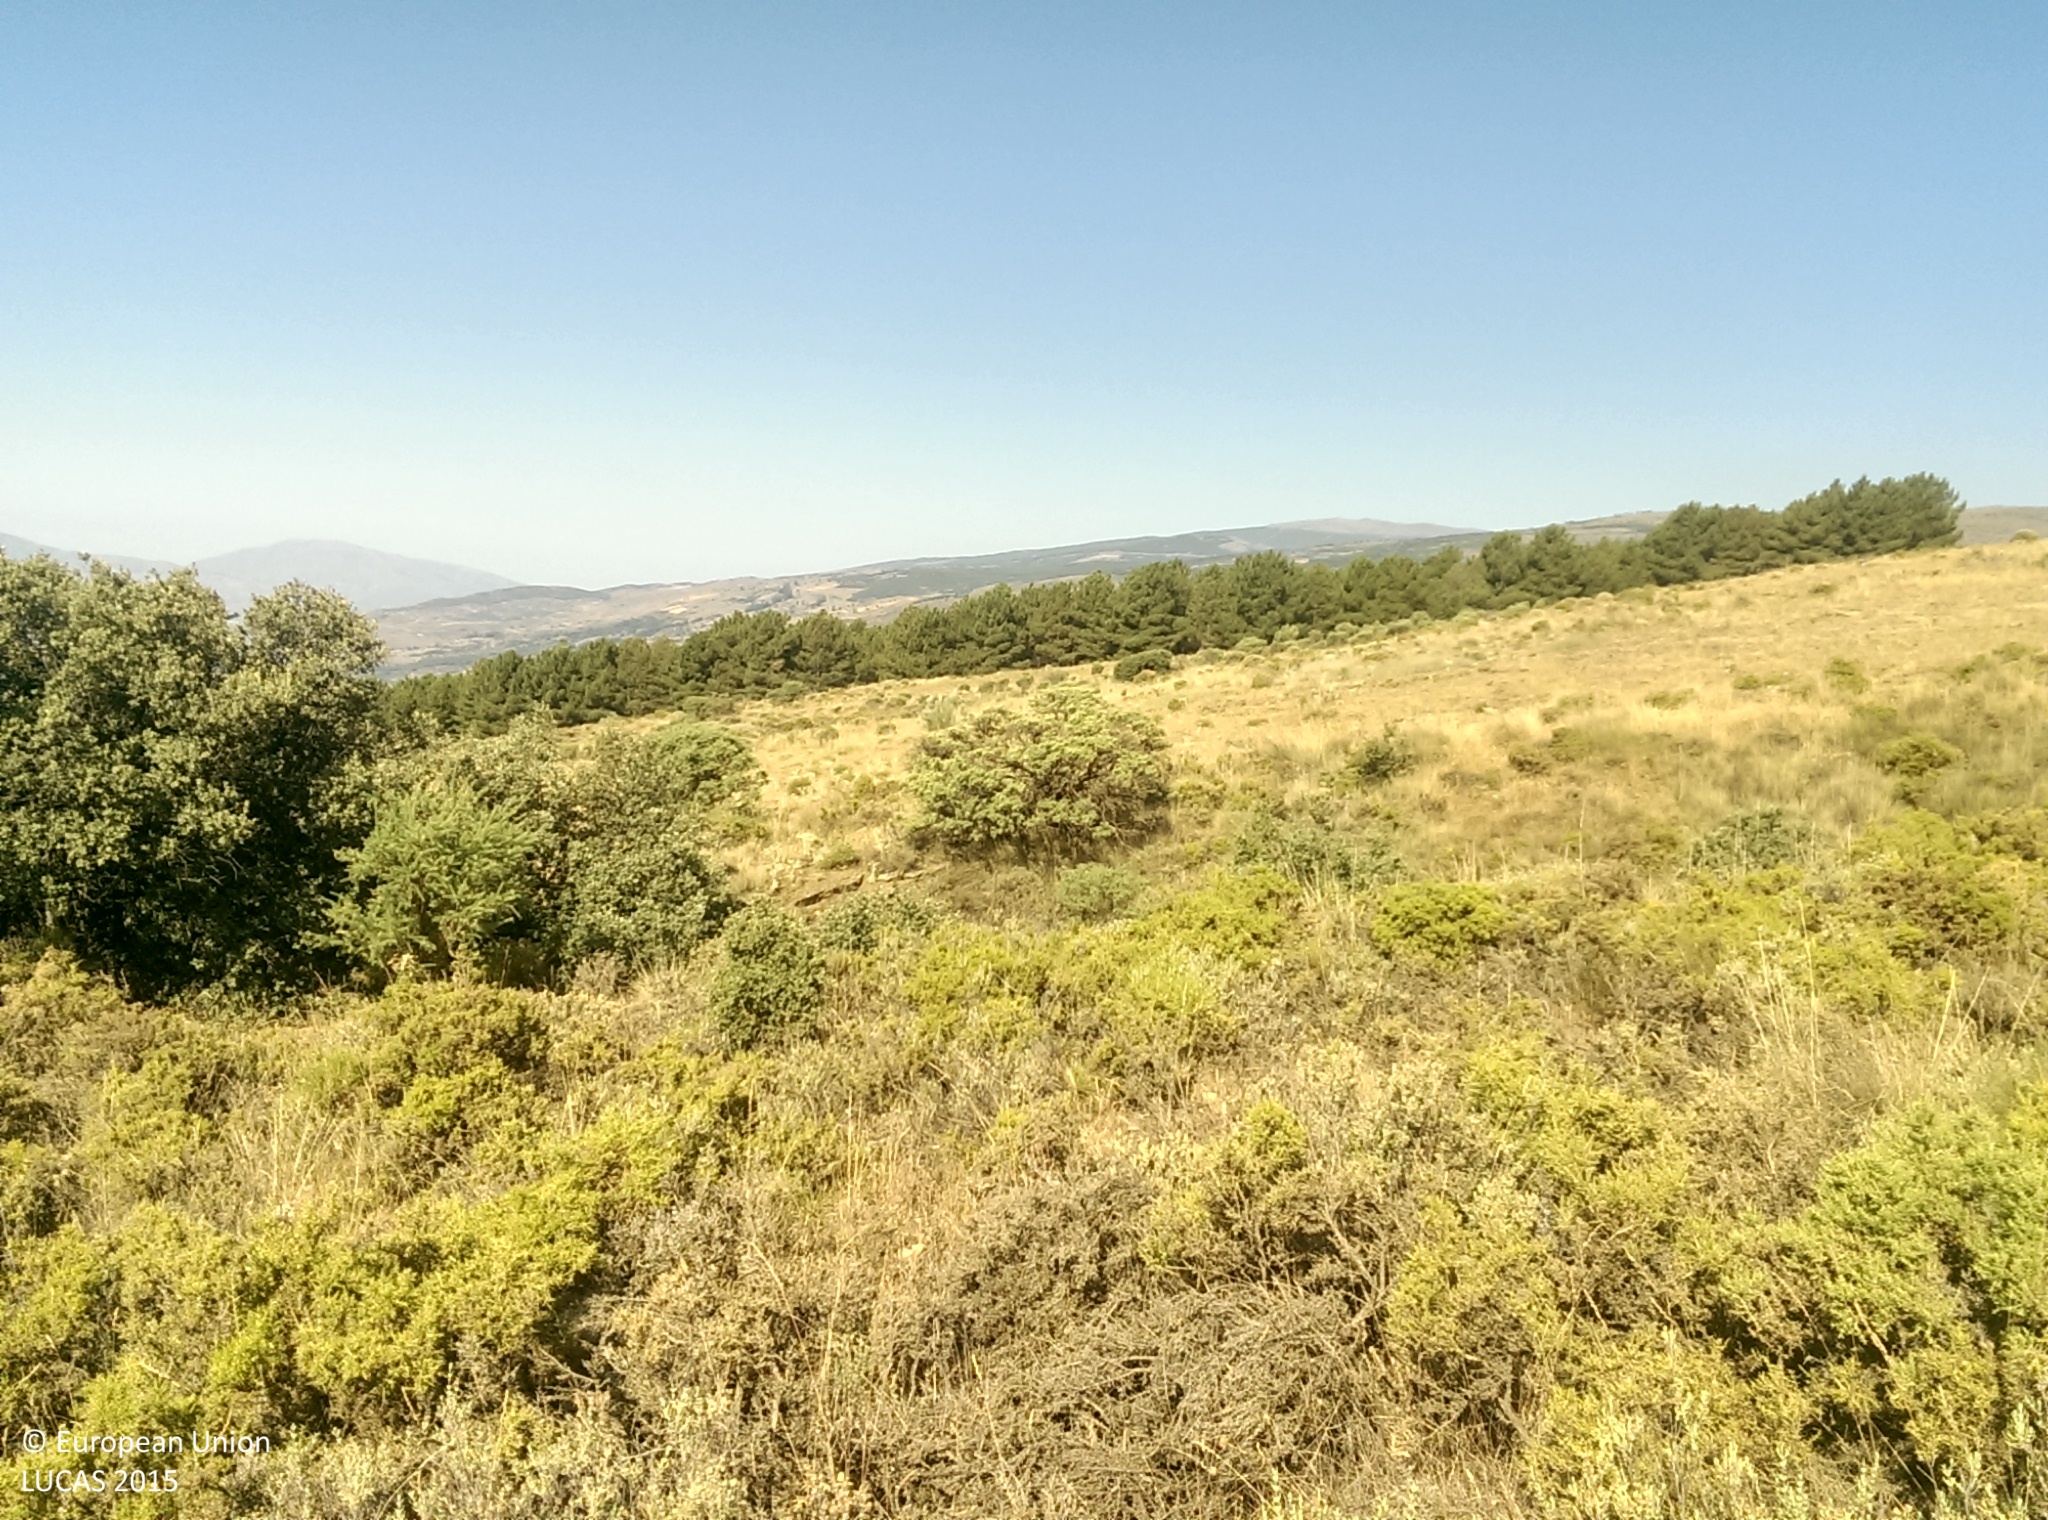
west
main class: Shrubland
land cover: Shrubland without tree cover
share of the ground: > 75 %
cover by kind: shrubs 75 %, herbaceous plants 20 %, unconsolidated bare surface 5 %
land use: Semi-natural and natural areas not in use
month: July
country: ES
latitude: 37.0268
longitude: -3.0554
